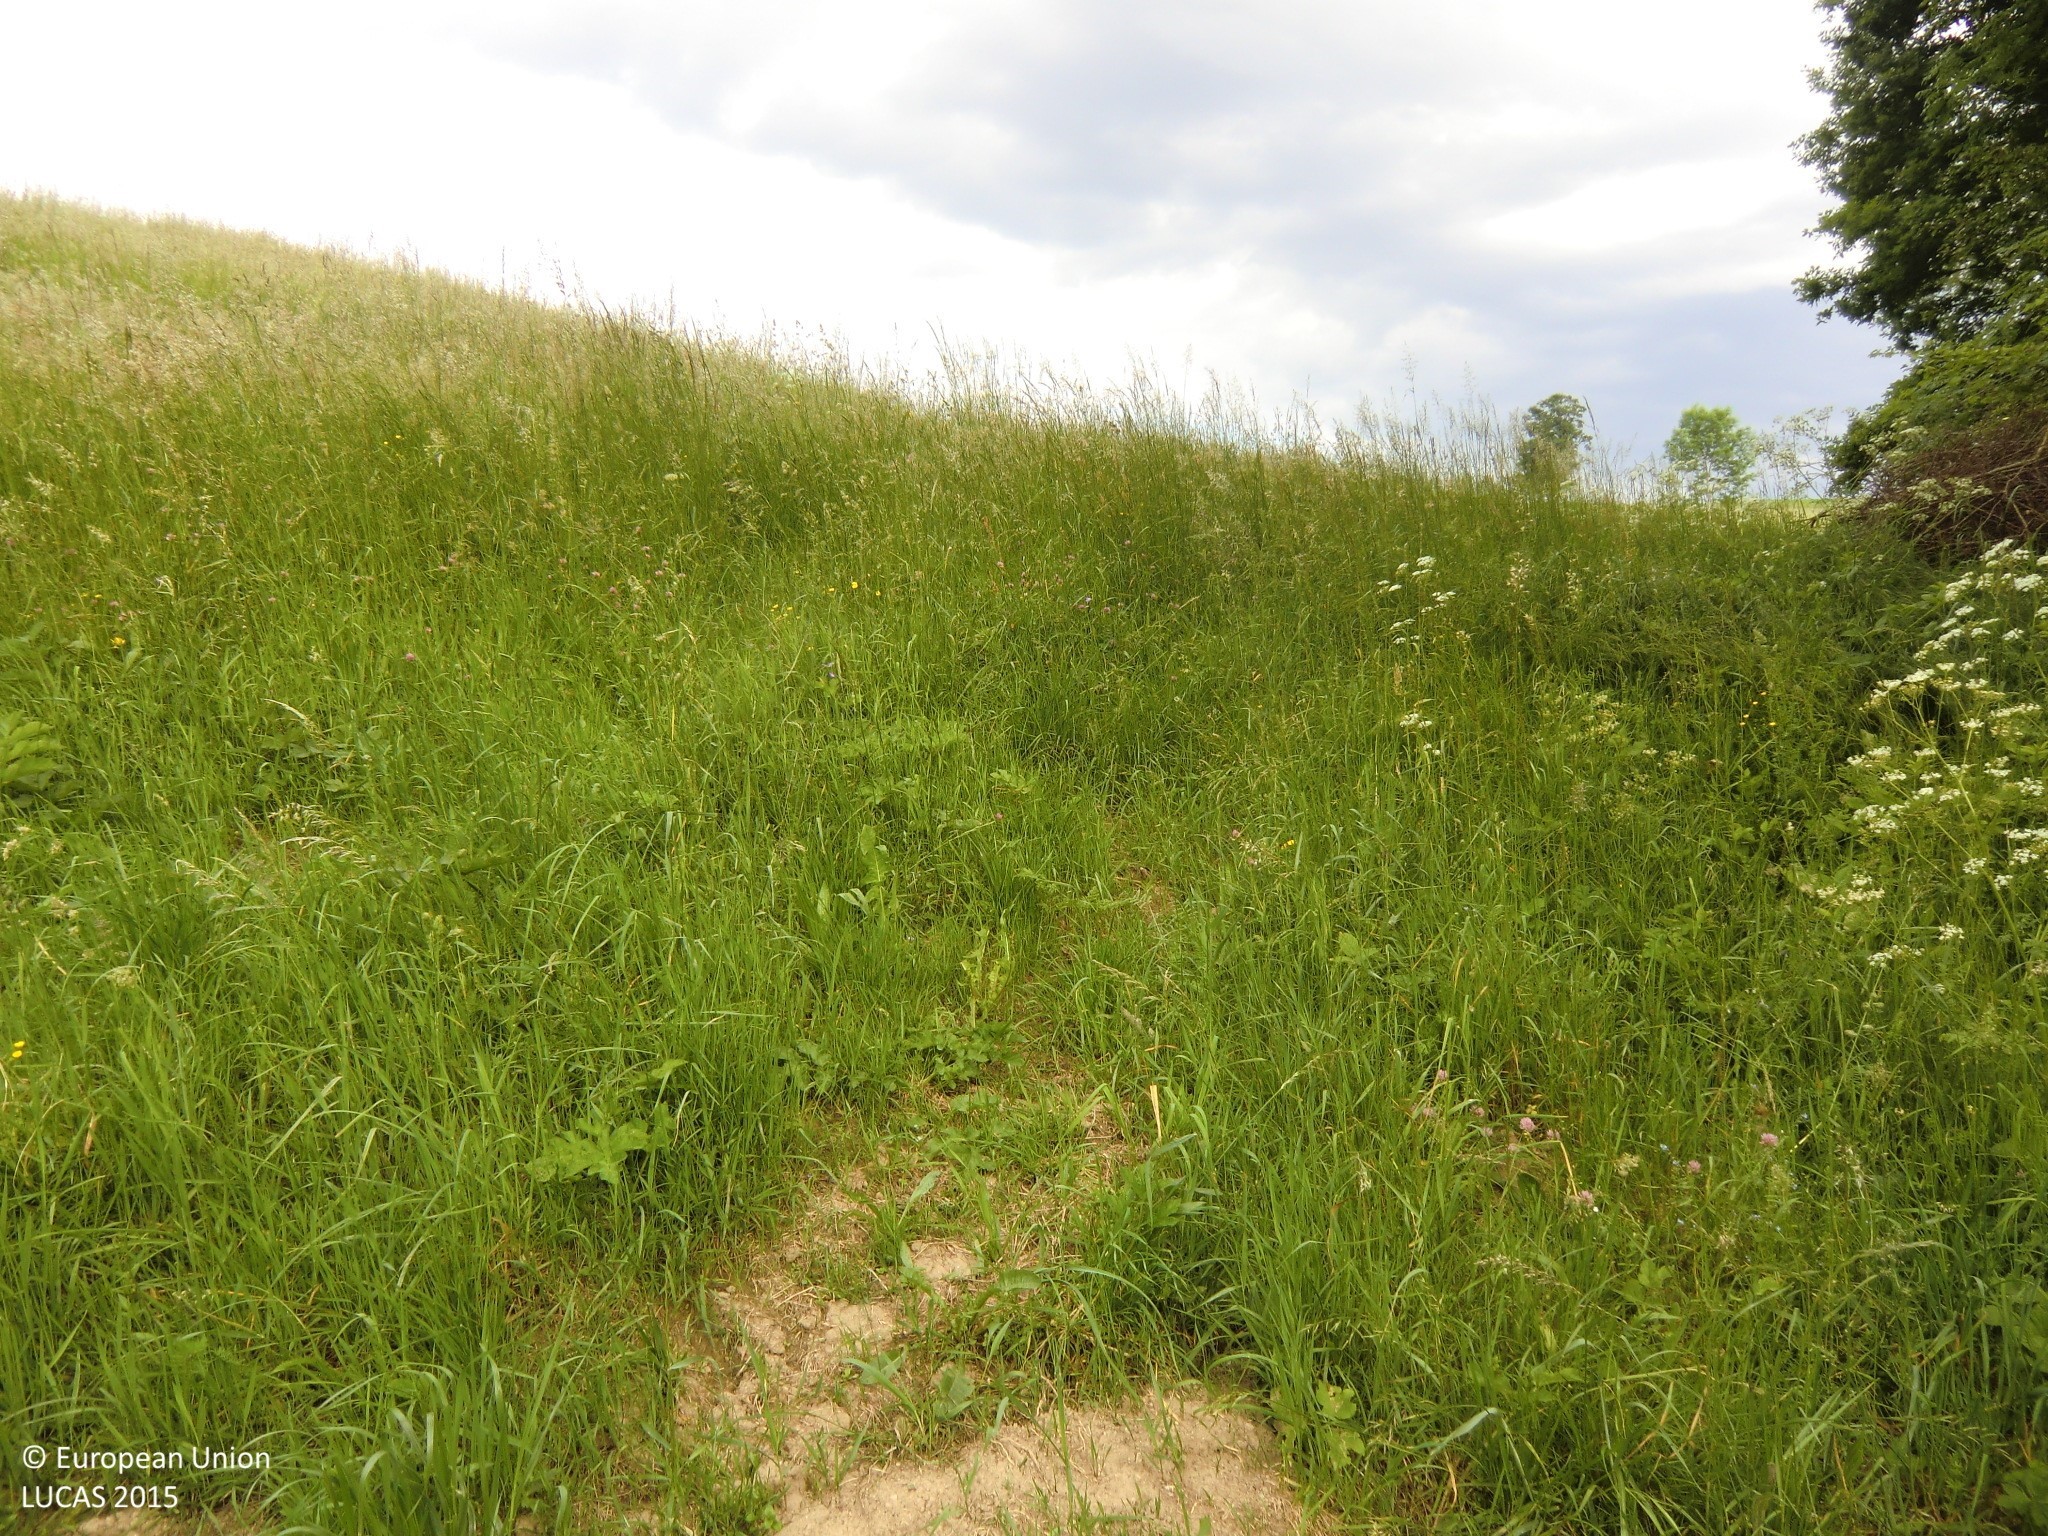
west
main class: Cropland
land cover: Maize
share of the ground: 10 - 25 %
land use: Agriculture (excluding fallow land and kitchen gardens)
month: June
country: AT
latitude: 48.2532
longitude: 15.0251
